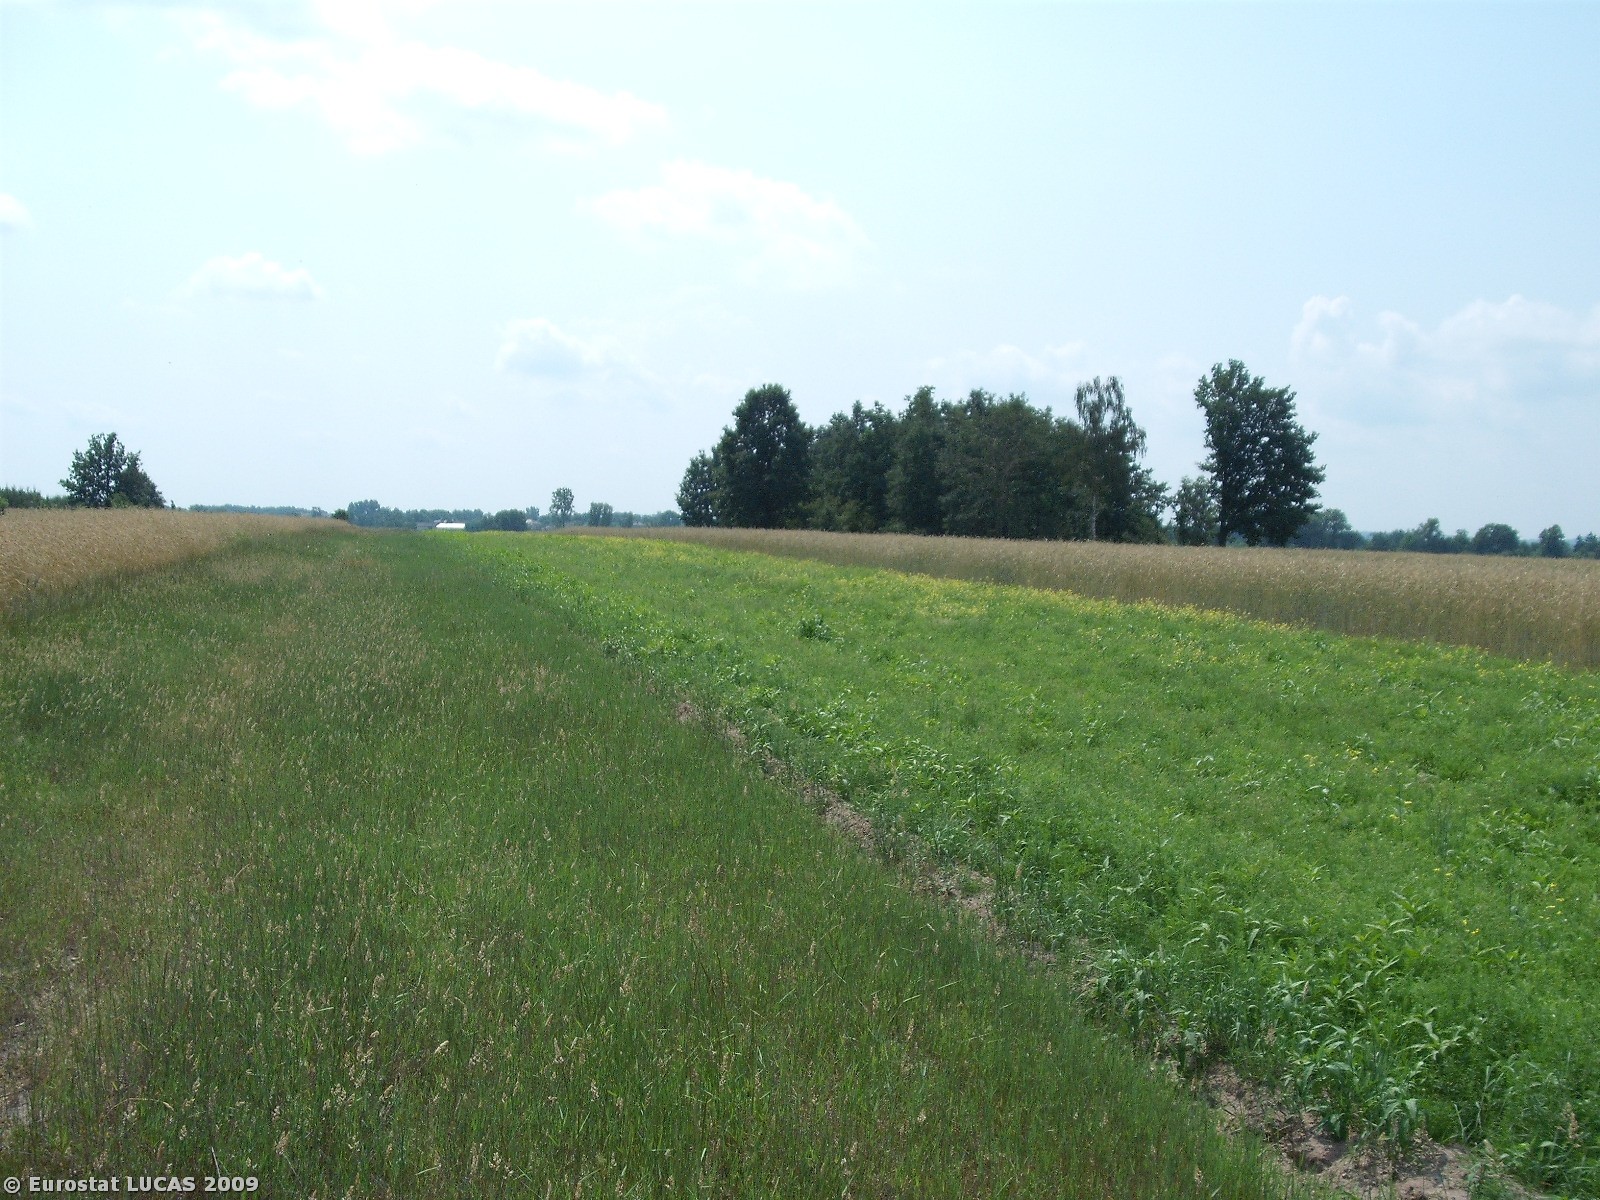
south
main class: Grassland
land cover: Spontaneously vegetated surfaces
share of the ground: > 75 %
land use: Fallow land
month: July
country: PL
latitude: 51.4492
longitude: 20.5869
